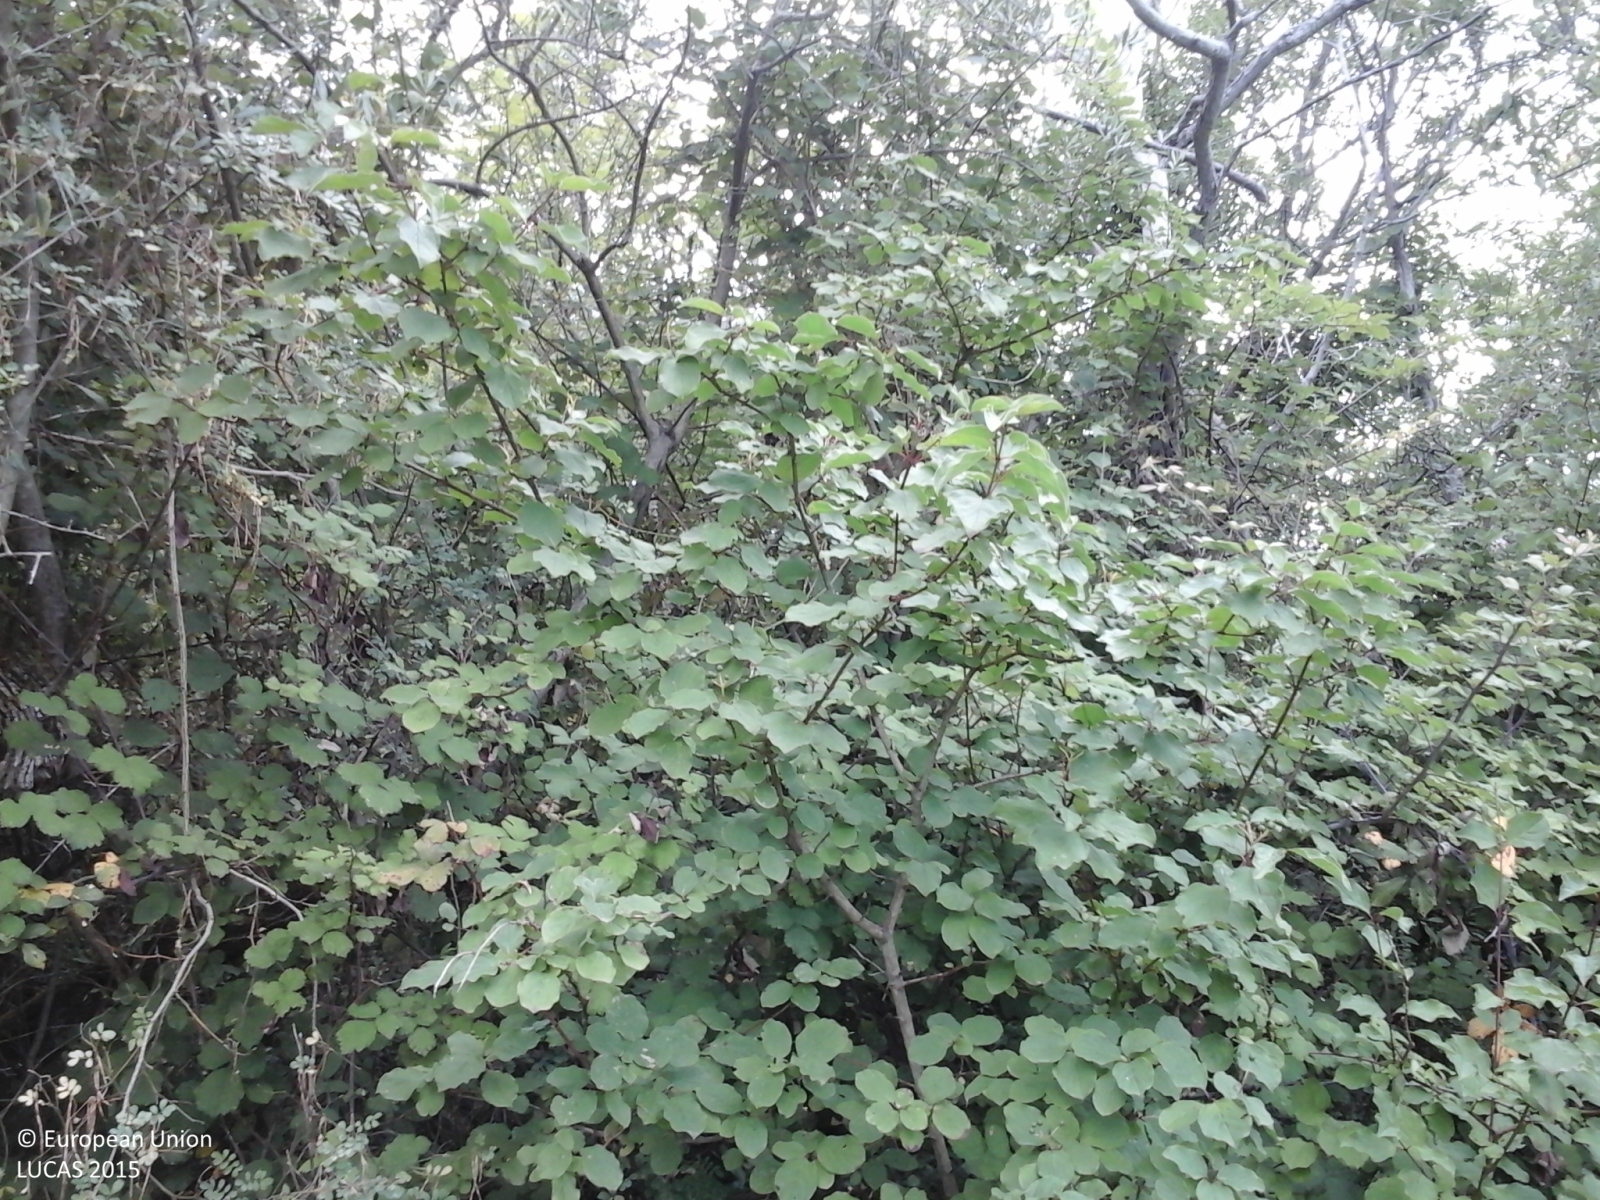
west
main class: Shrubland
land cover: Shrubland with sparse tree cover
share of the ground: > 75 %
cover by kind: shrubs 90 %, broadleaved forest trees 5 %, herbaceous plants 5 %
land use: Semi-natural and natural areas not in use
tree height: < 5 m
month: June
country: IT
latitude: 42.0954
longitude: 14.2303
